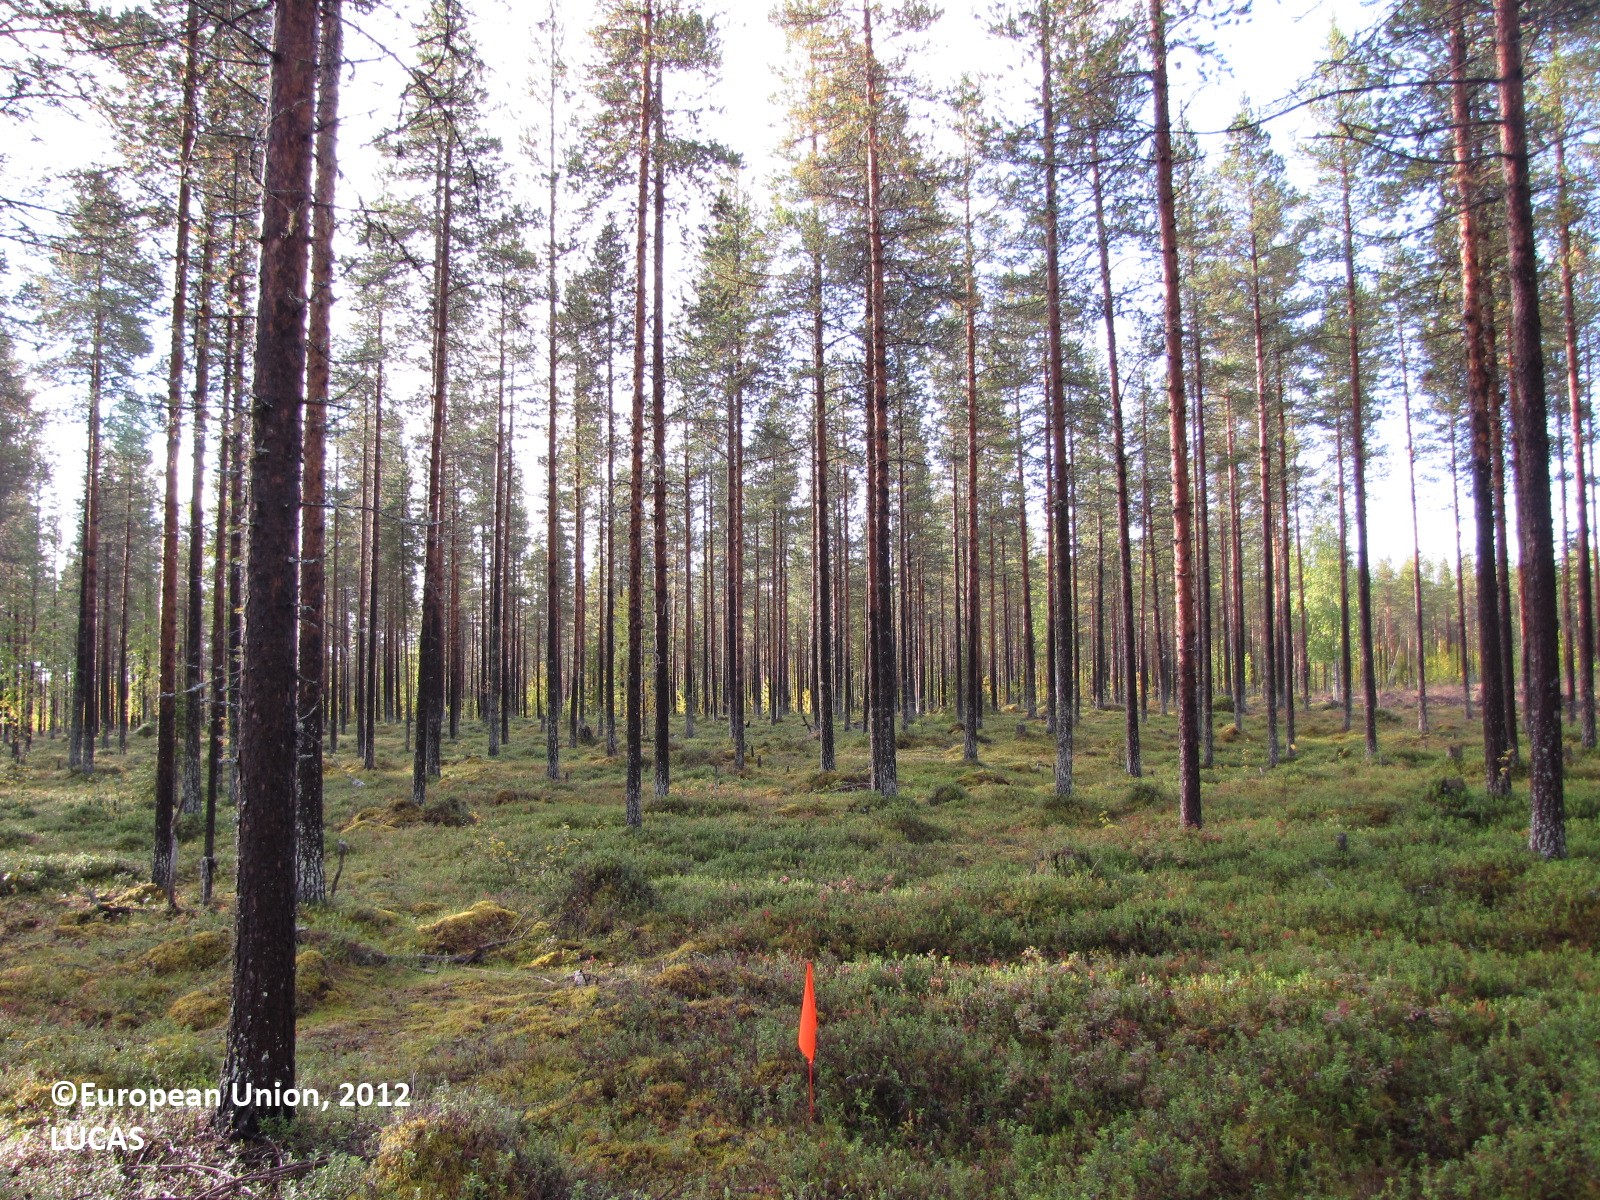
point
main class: Woodland
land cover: Pine dominated coniferous woodland
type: boreal forest
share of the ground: 50 - 75 %
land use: Forestry
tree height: > 5 m
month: September
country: FI
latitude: 67.2491
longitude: 25.4142
